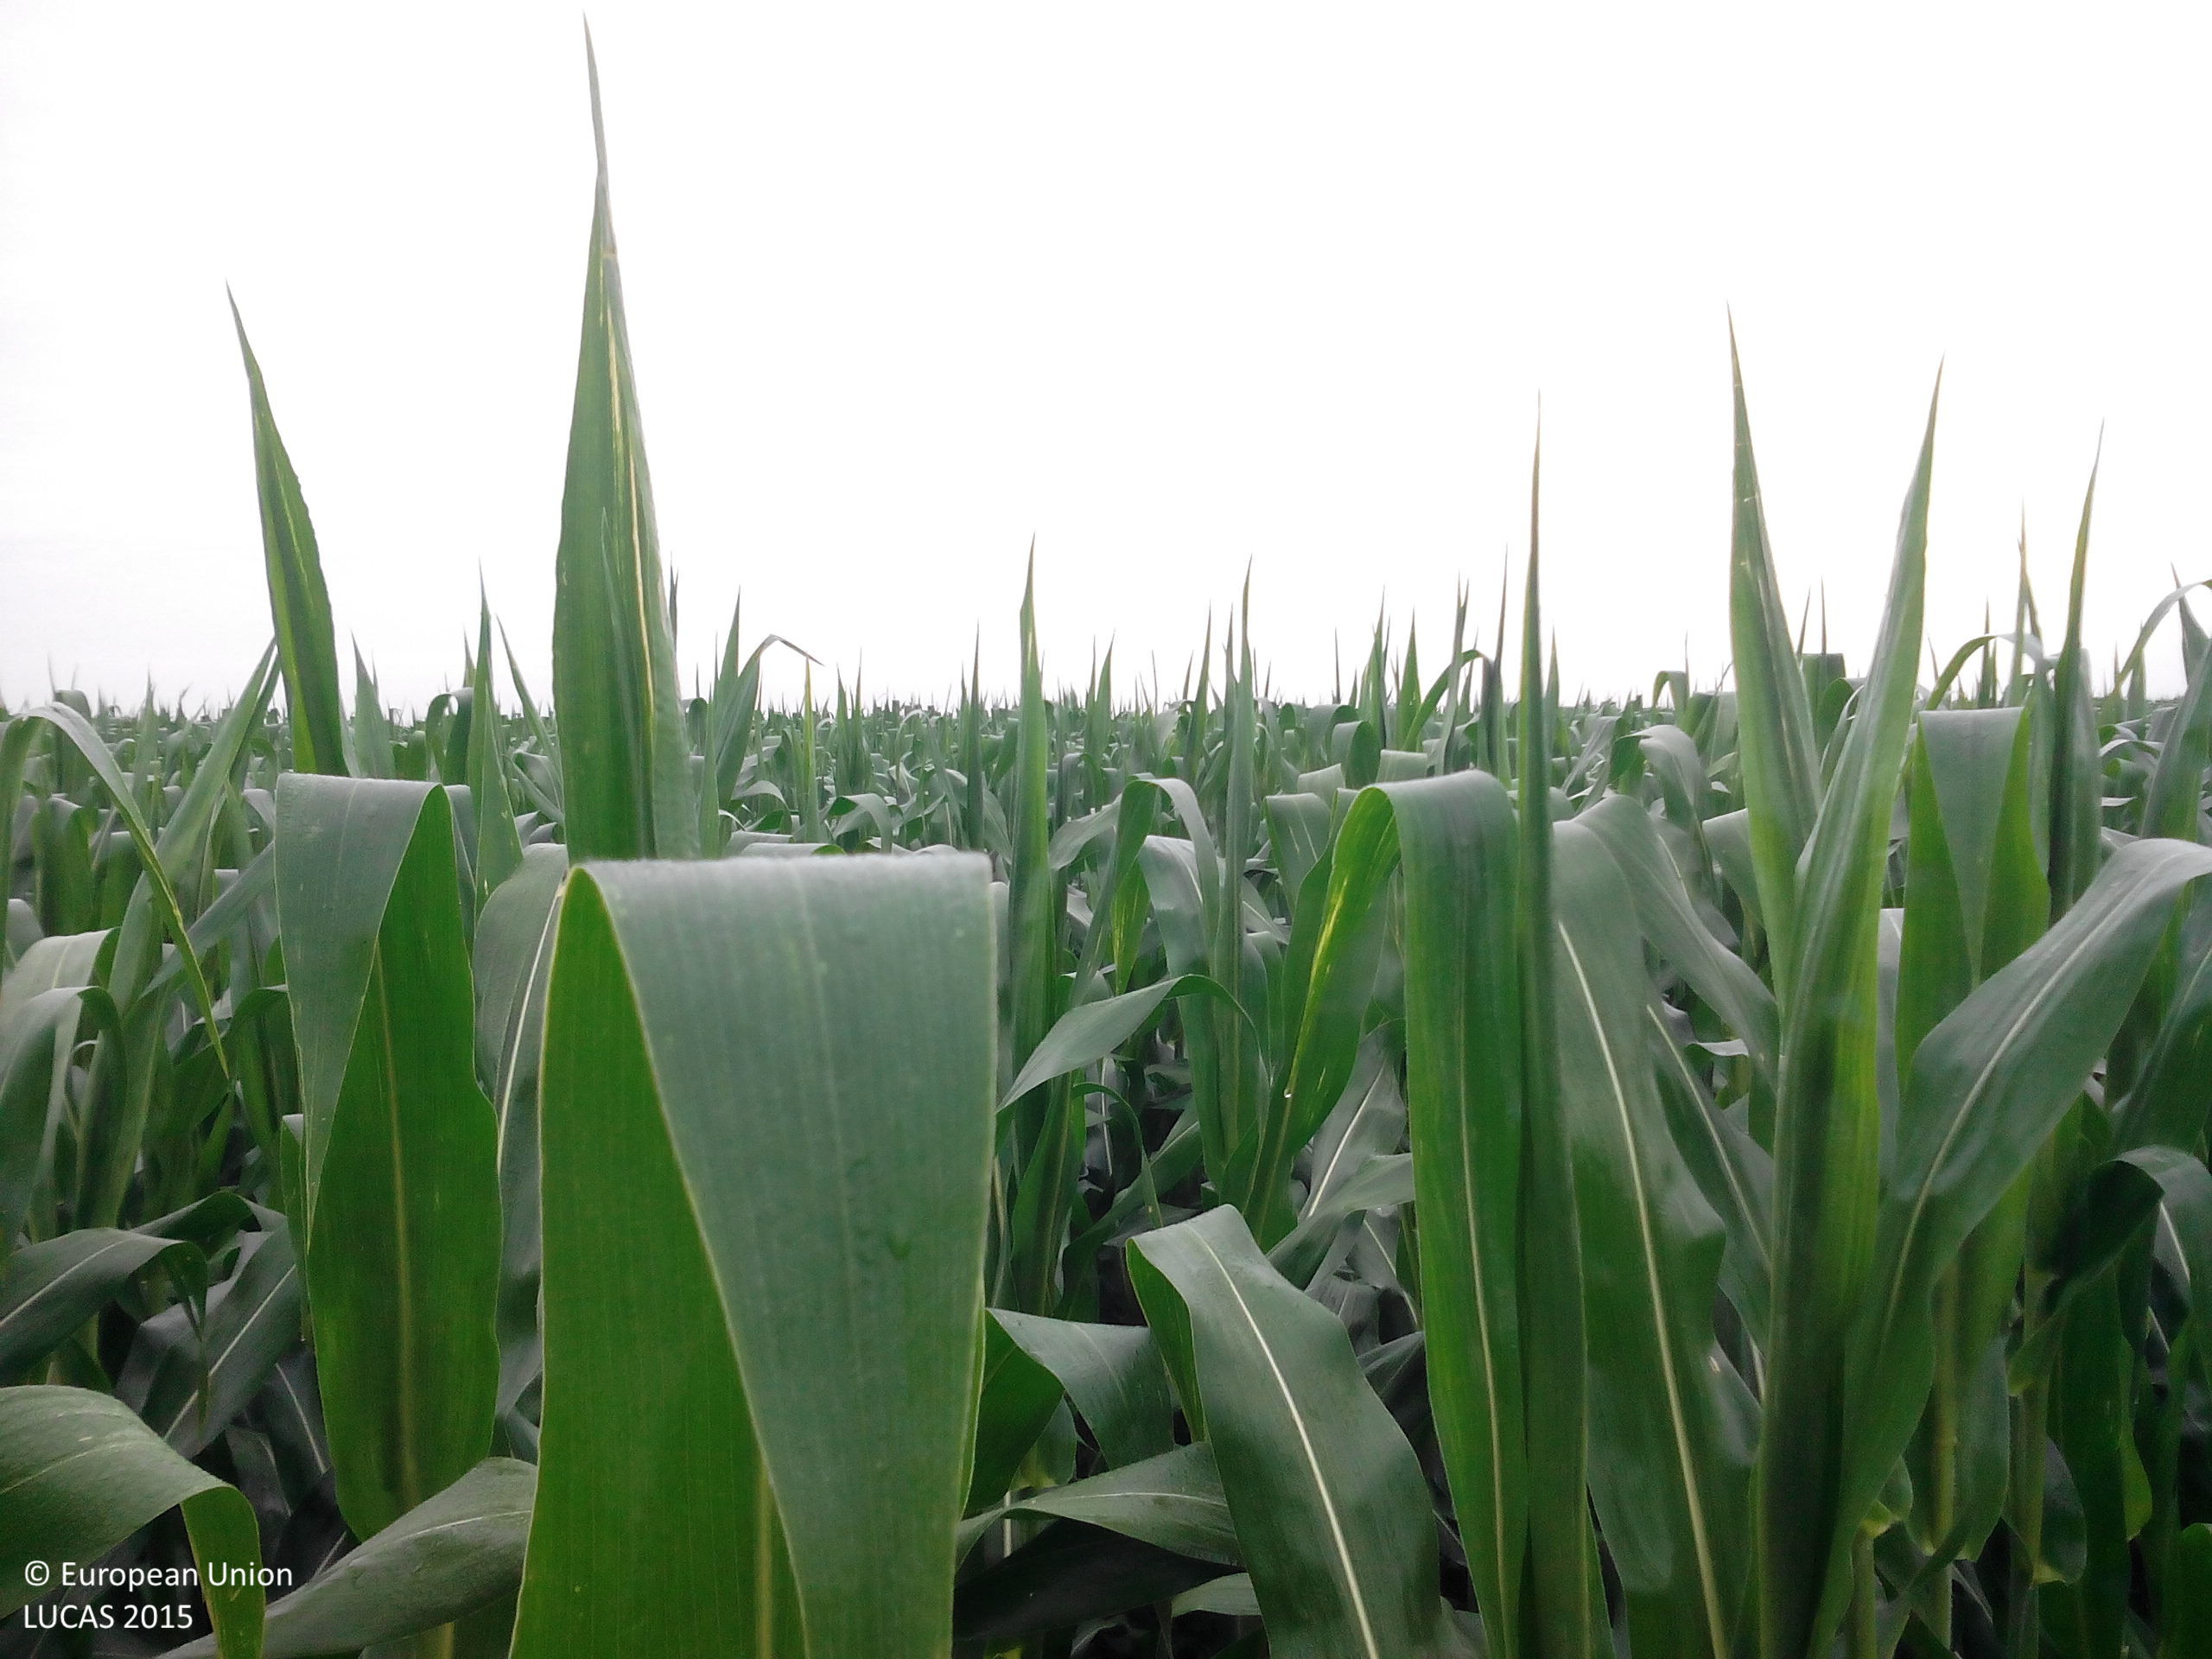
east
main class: Cropland
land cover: Maize
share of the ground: > 75 %
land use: Agriculture (excluding fallow land and kitchen gardens)
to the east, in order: Maize
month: July
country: BG
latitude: 43.4689
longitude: 24.1341
